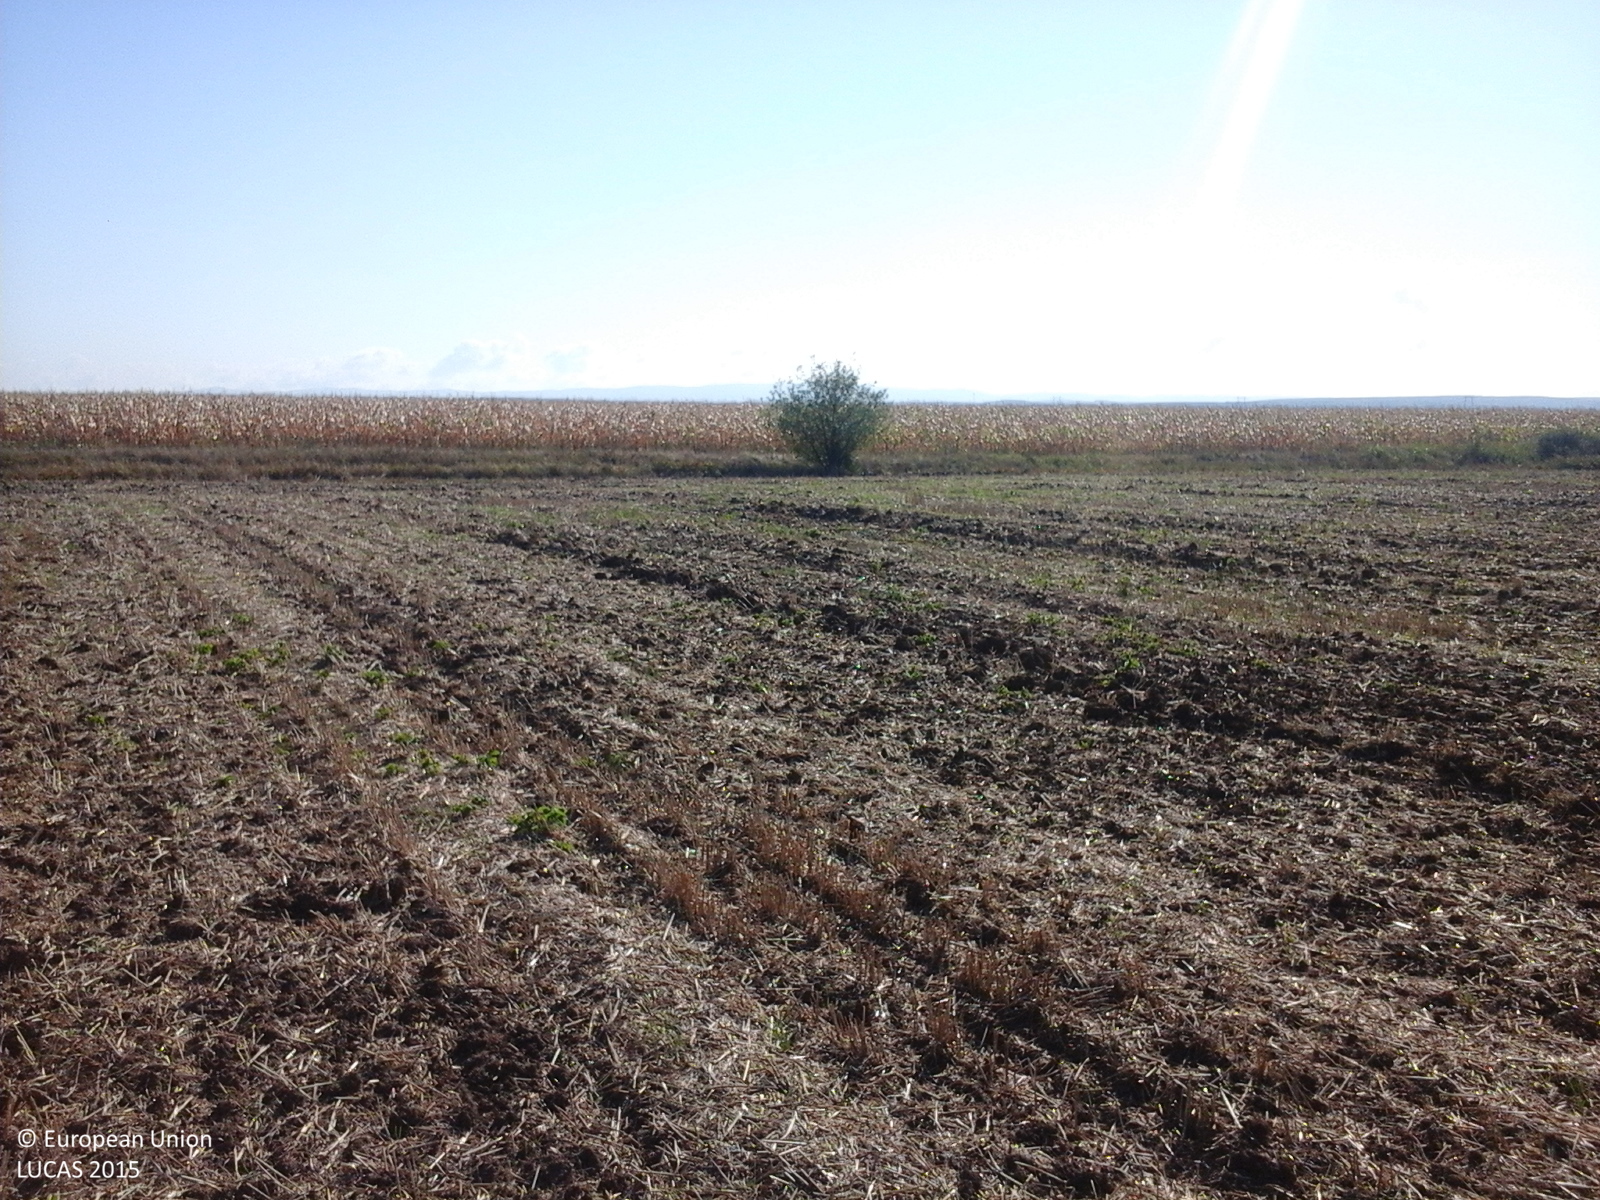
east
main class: Cropland
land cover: Common wheat
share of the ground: 25 - 50 %
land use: Agriculture (excluding fallow land and kitchen gardens)
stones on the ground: < 10 %
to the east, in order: Common wheat; Grass margins; Ditches and canals; Grass margins; Tracks; Grass margins; Maize
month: September
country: RO
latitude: 47.5669
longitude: 22.7823
